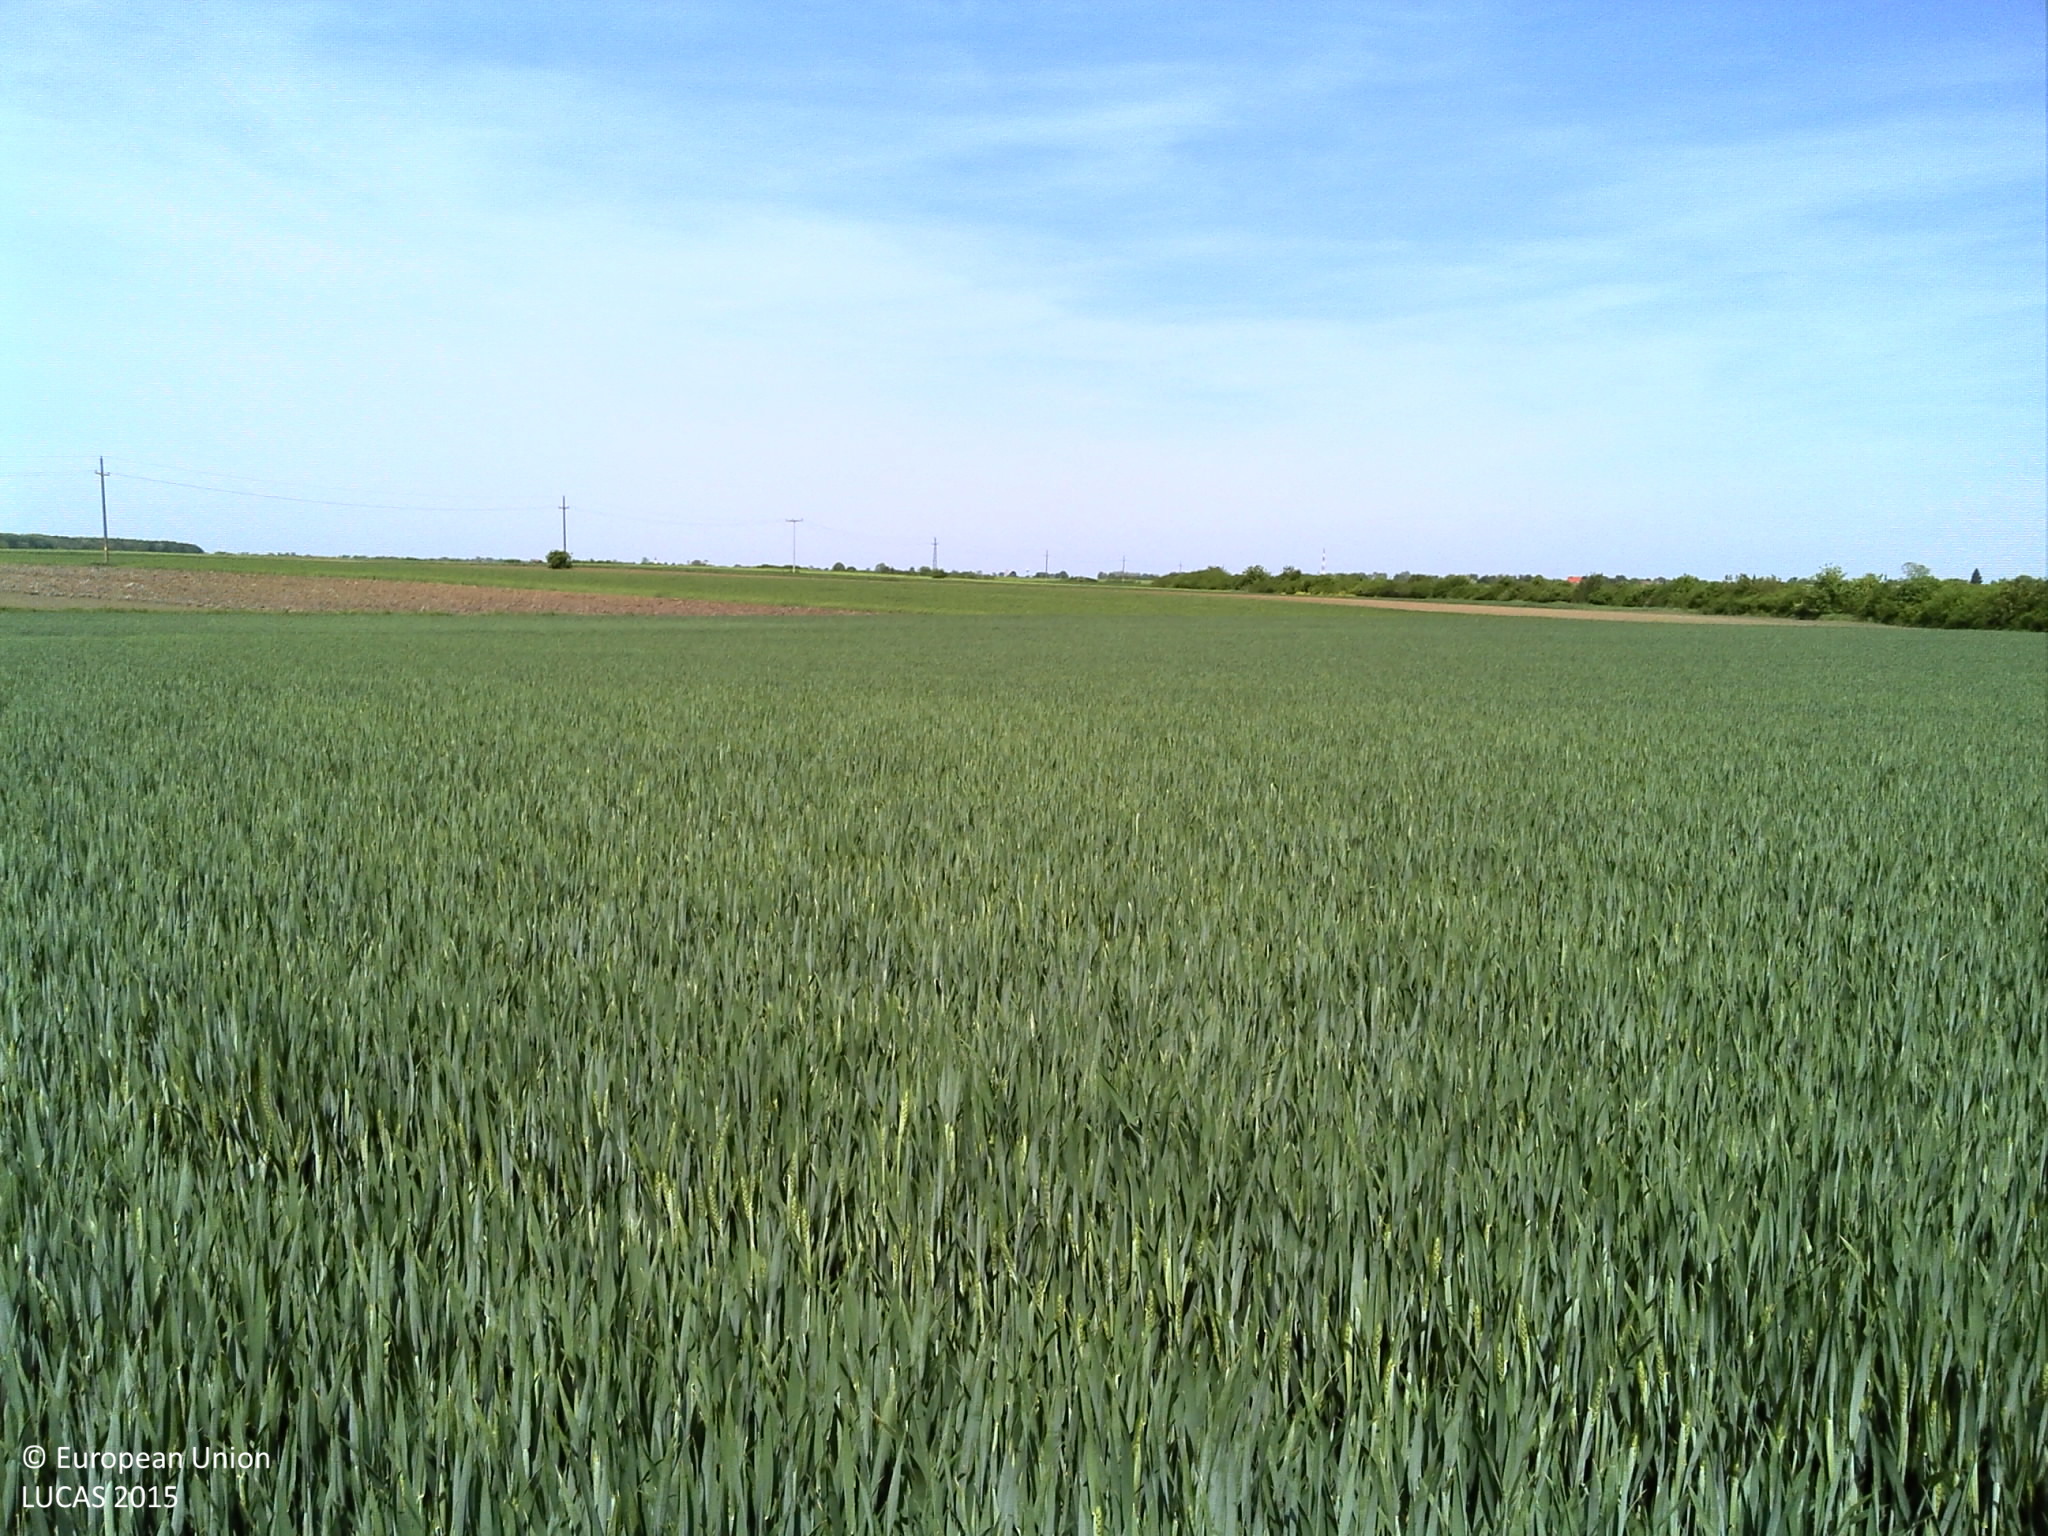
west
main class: Cropland
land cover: Common wheat
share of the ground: > 75 %
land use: Agriculture (excluding fallow land and kitchen gardens)
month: May
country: HR
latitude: 45.3987
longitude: 18.9124
